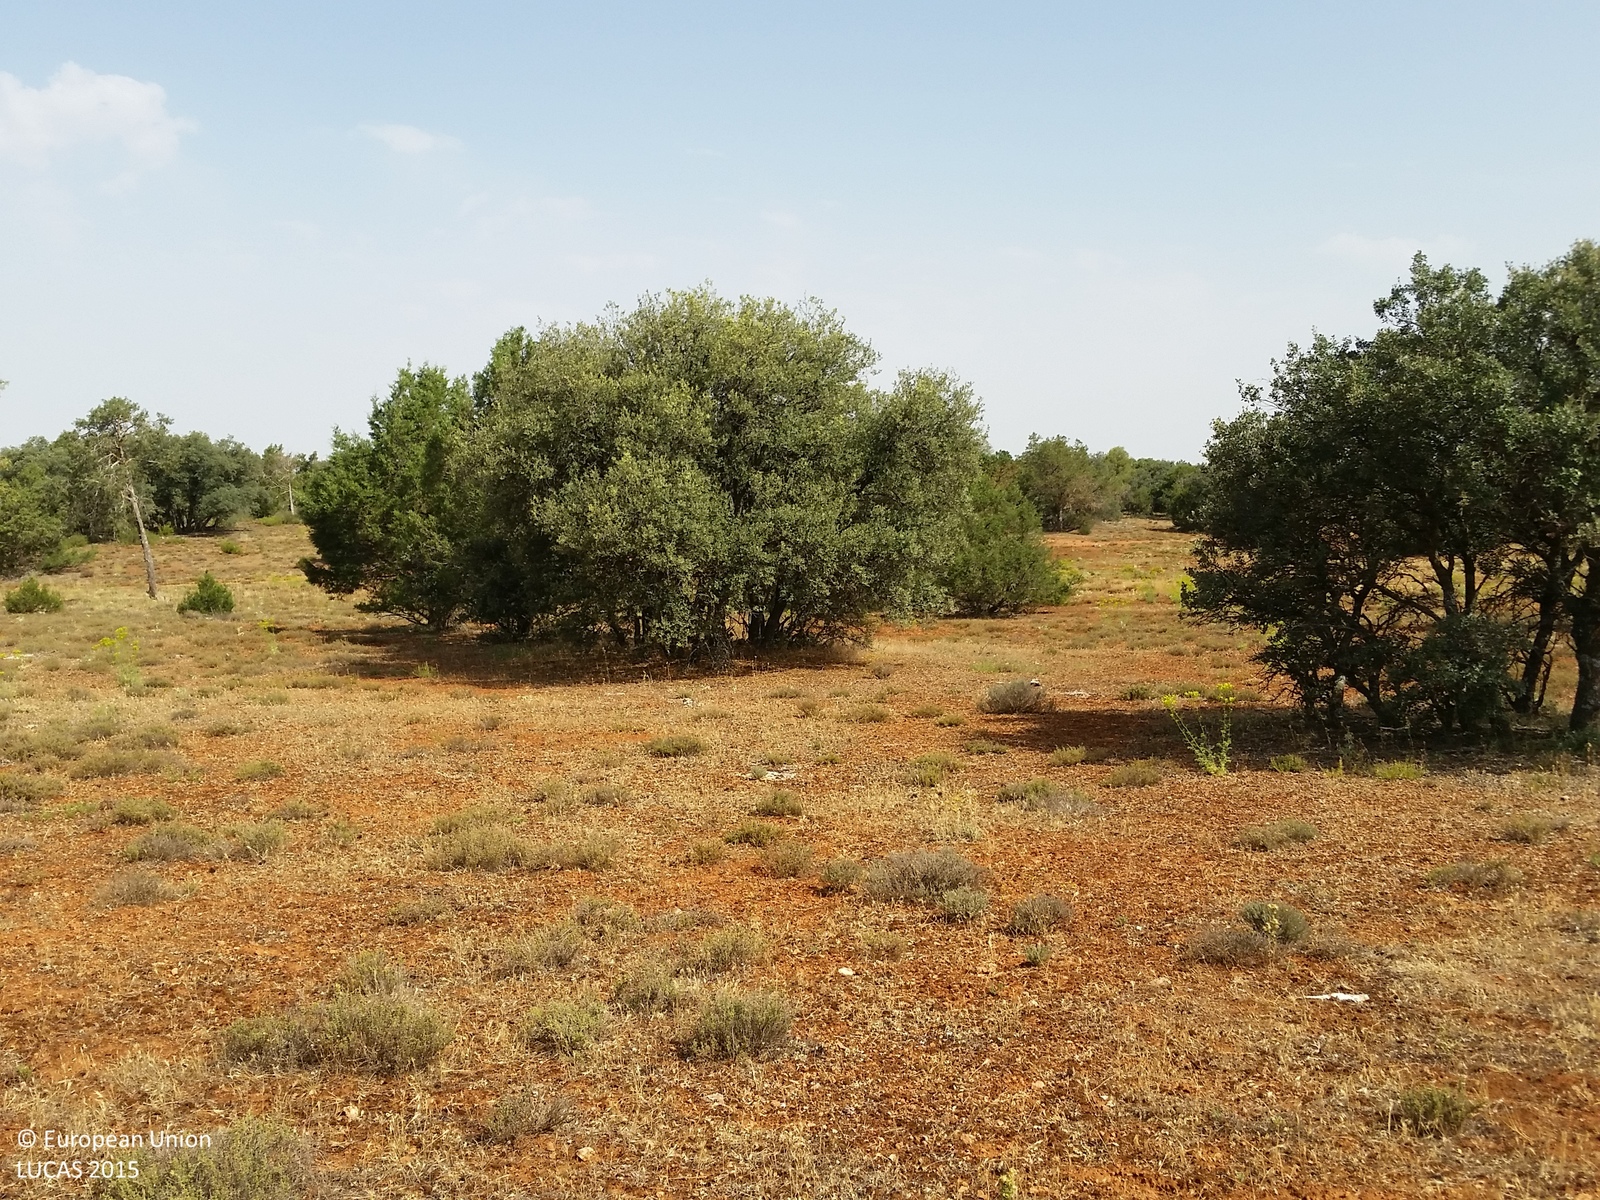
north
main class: Woodland
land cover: Pine dominated coniferous woodland
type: coniferous forest of the mediterranean region
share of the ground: > 75 %
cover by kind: coniferous forest trees 50 %, shrubs 20 %, herbaceous plants 15 %, consolidated bare surface 15 %
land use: Semi-natural and natural areas not in use
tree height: > 5 m
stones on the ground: 10 - 25 %
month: July
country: ES
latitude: 38.8925
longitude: -2.6765
